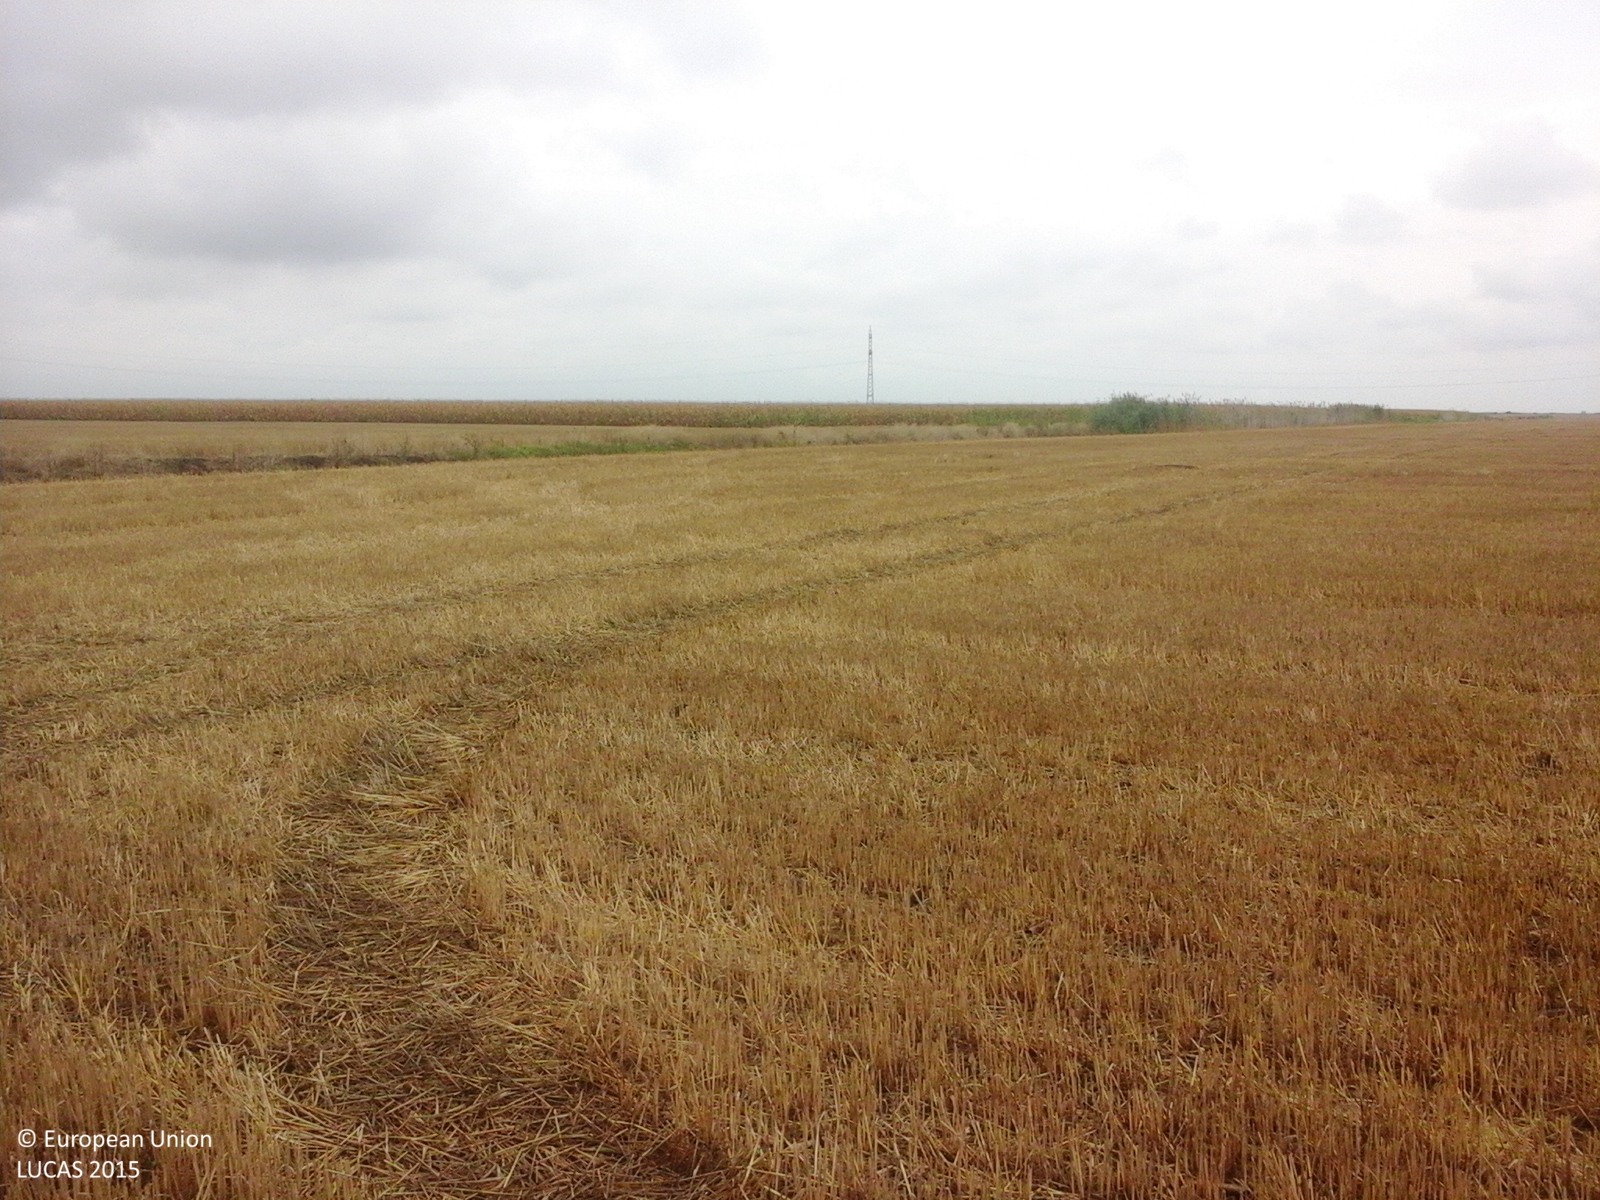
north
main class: Cropland
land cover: Common wheat
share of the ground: > 75 %
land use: Agriculture (excluding fallow land and kitchen gardens)
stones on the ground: < 10 %
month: August
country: RO
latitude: 45.8084
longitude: 20.7447
